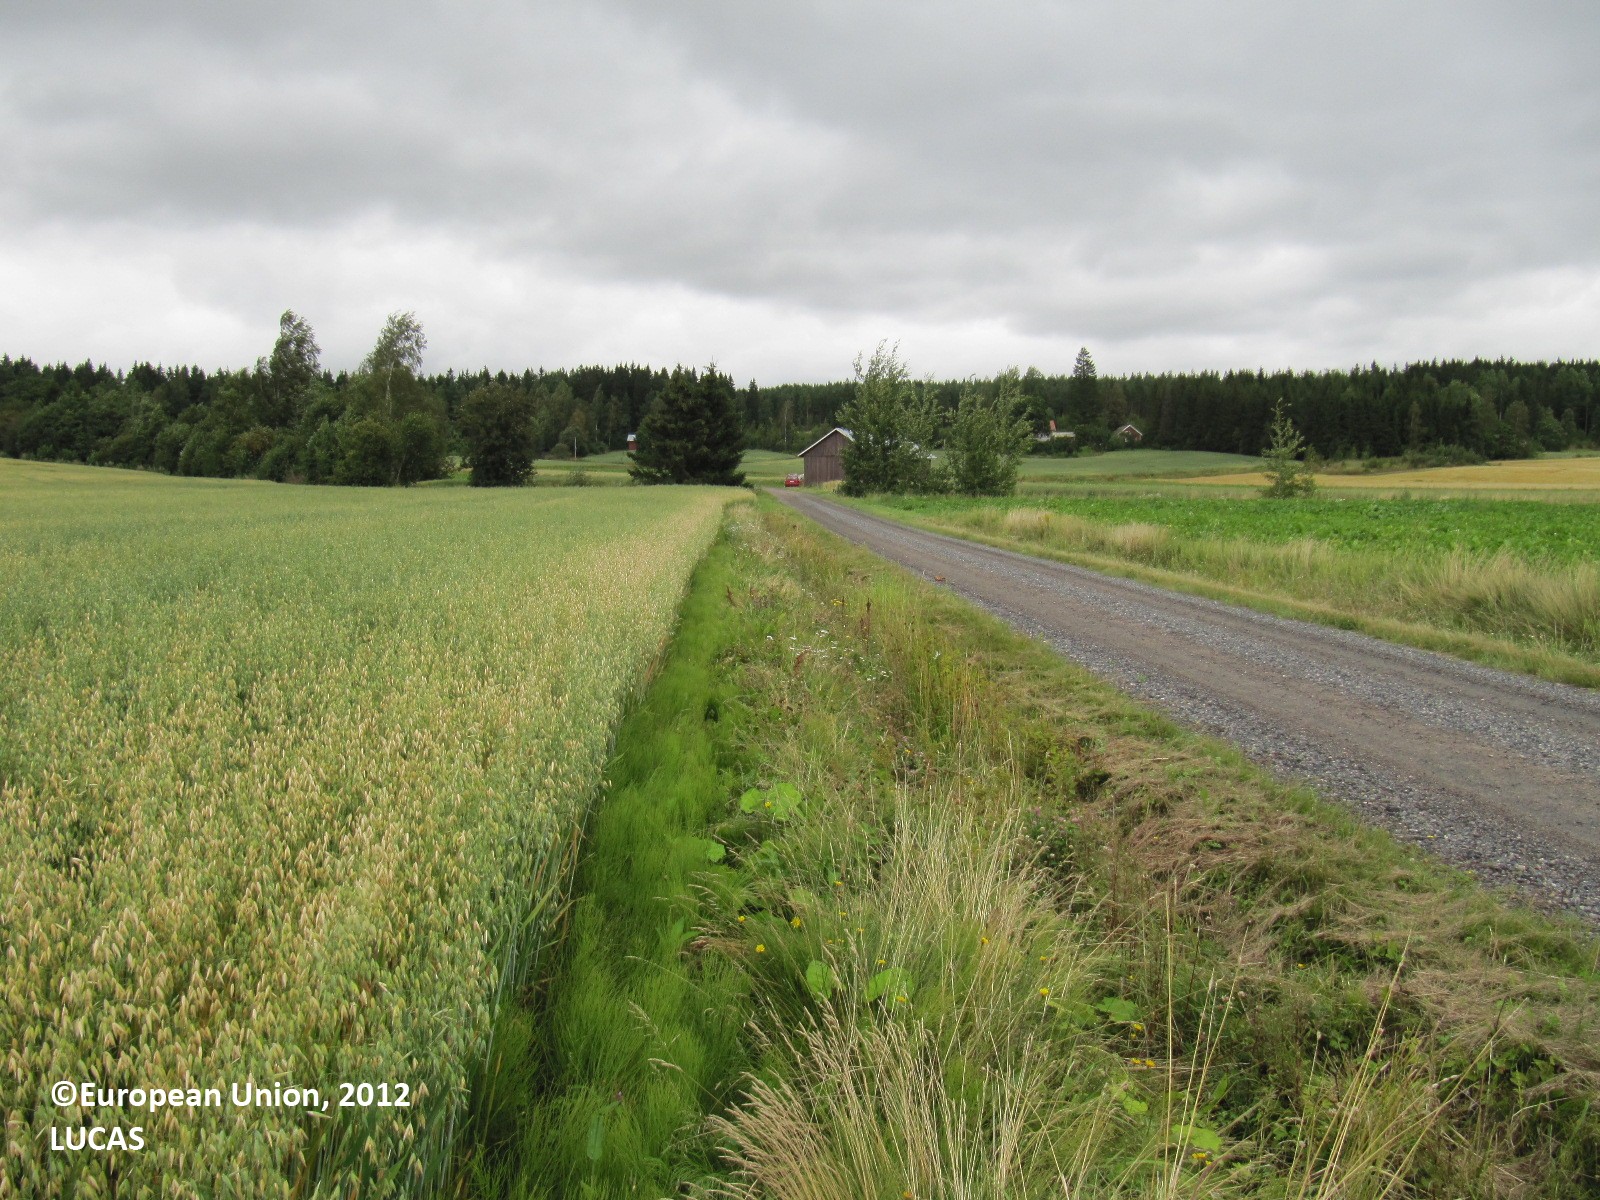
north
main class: Cropland
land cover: Oats
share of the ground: > 75 %
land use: Agriculture (excluding fallow land and kitchen gardens)
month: August
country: FI
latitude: 60.1785
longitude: 23.0059
